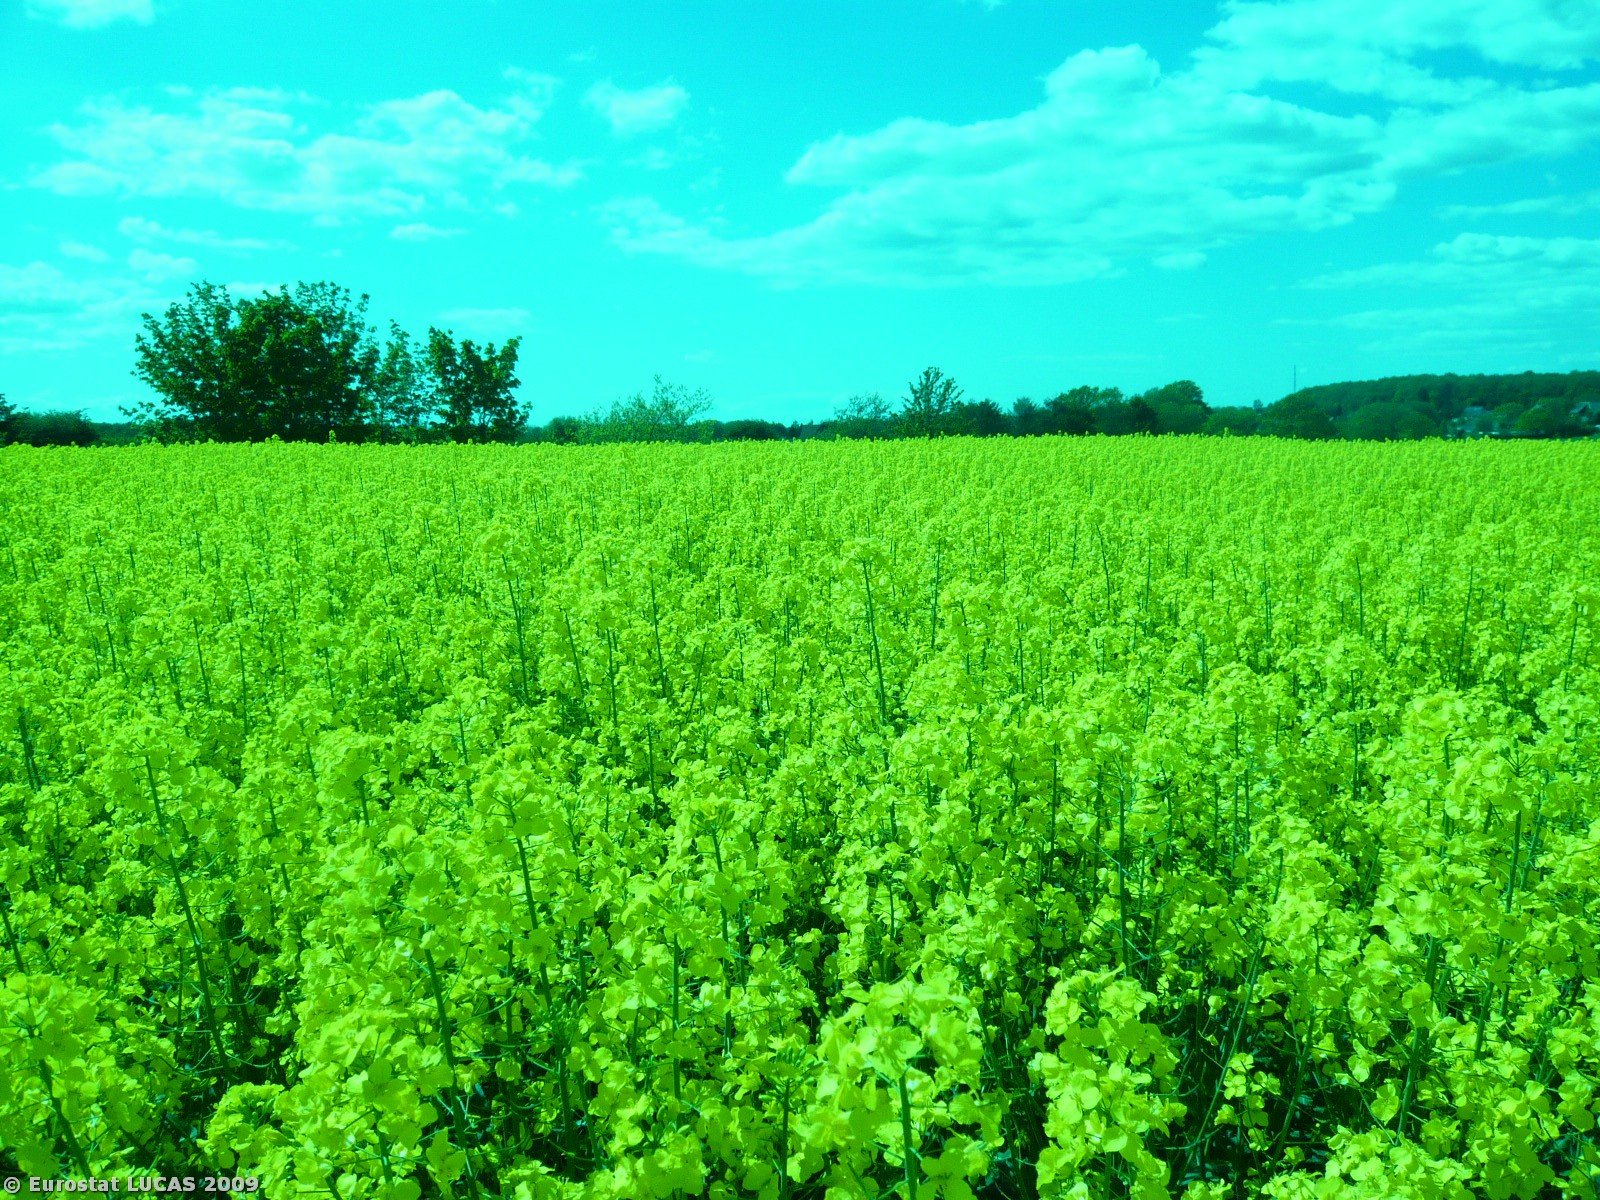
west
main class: Cropland
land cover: Rape and turnip rape
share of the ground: > 75 %
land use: Agriculture (excluding fallow land and kitchen gardens)
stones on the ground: < 10 %
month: May
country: DK
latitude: 55.0037
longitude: 11.9842
